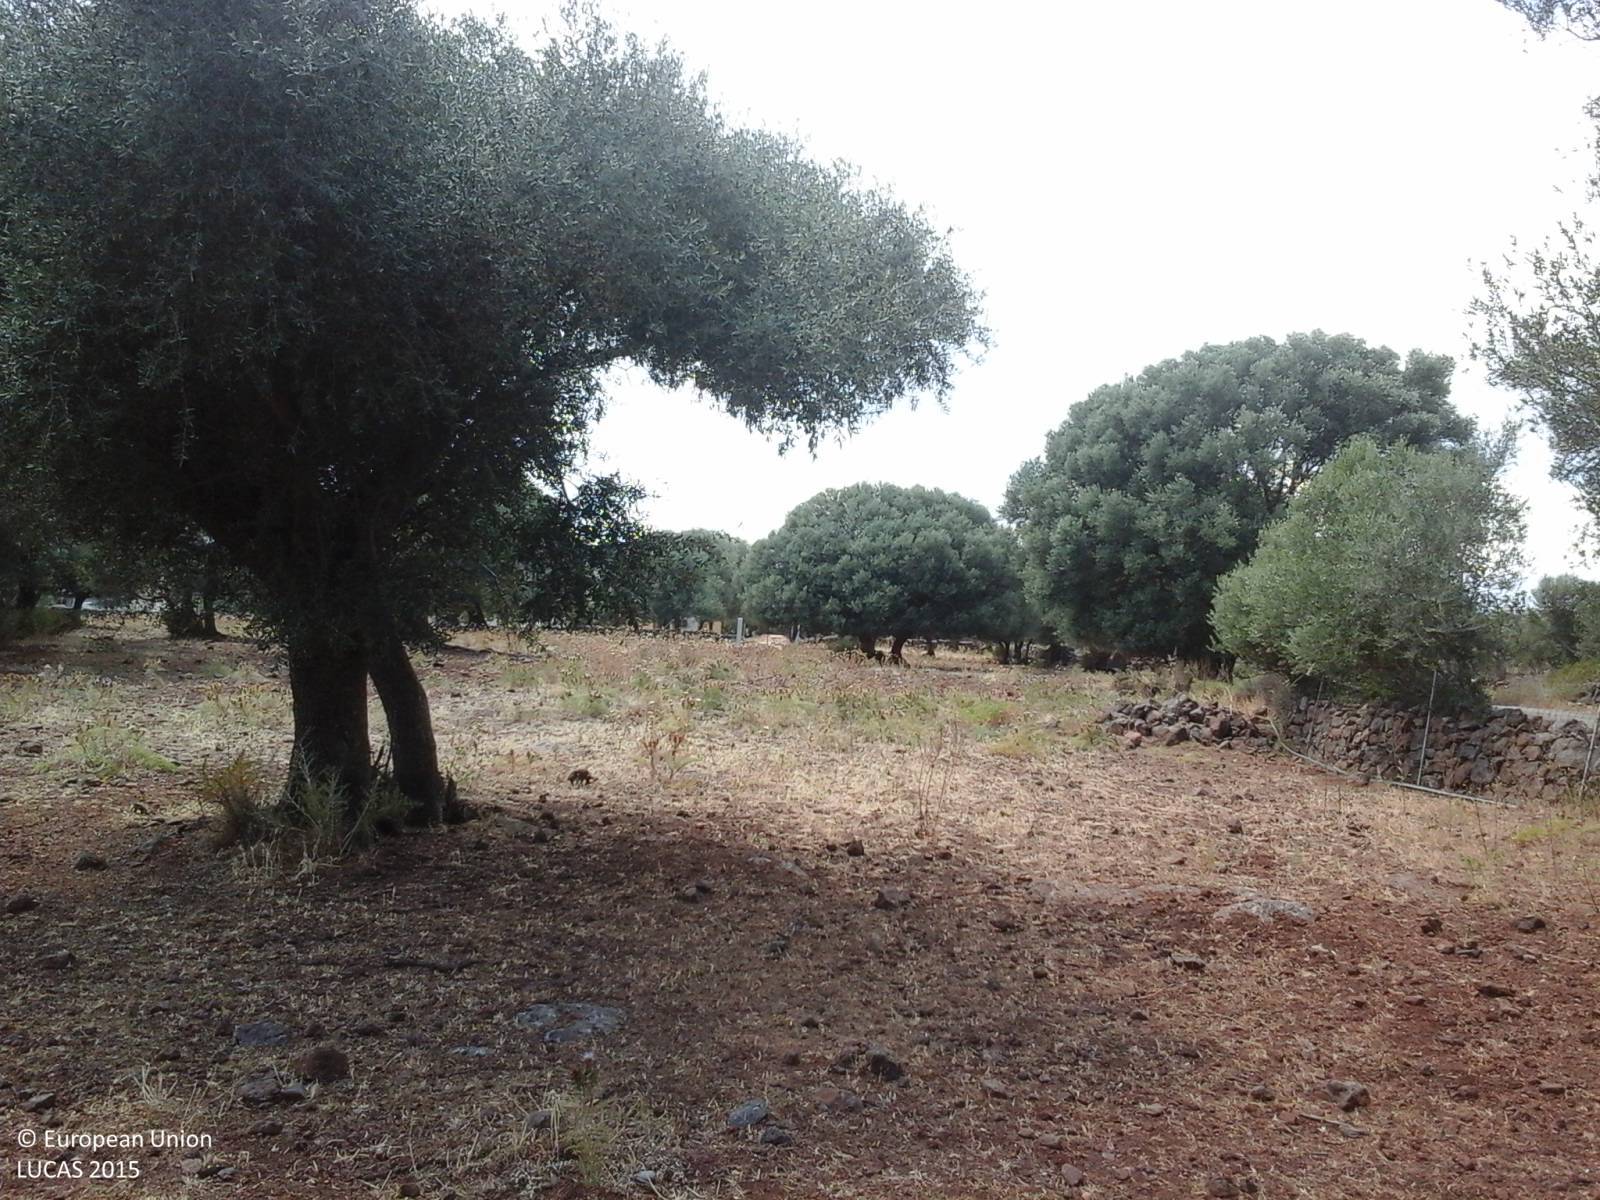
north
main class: Shrubland
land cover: Shrubland without tree cover
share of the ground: > 75 %
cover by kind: shrubs 90 %, herbaceous plants 10 %
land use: Agriculture (excluding fallow land and kitchen gardens)
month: June
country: IT
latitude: 40.3391
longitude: 9.6370
